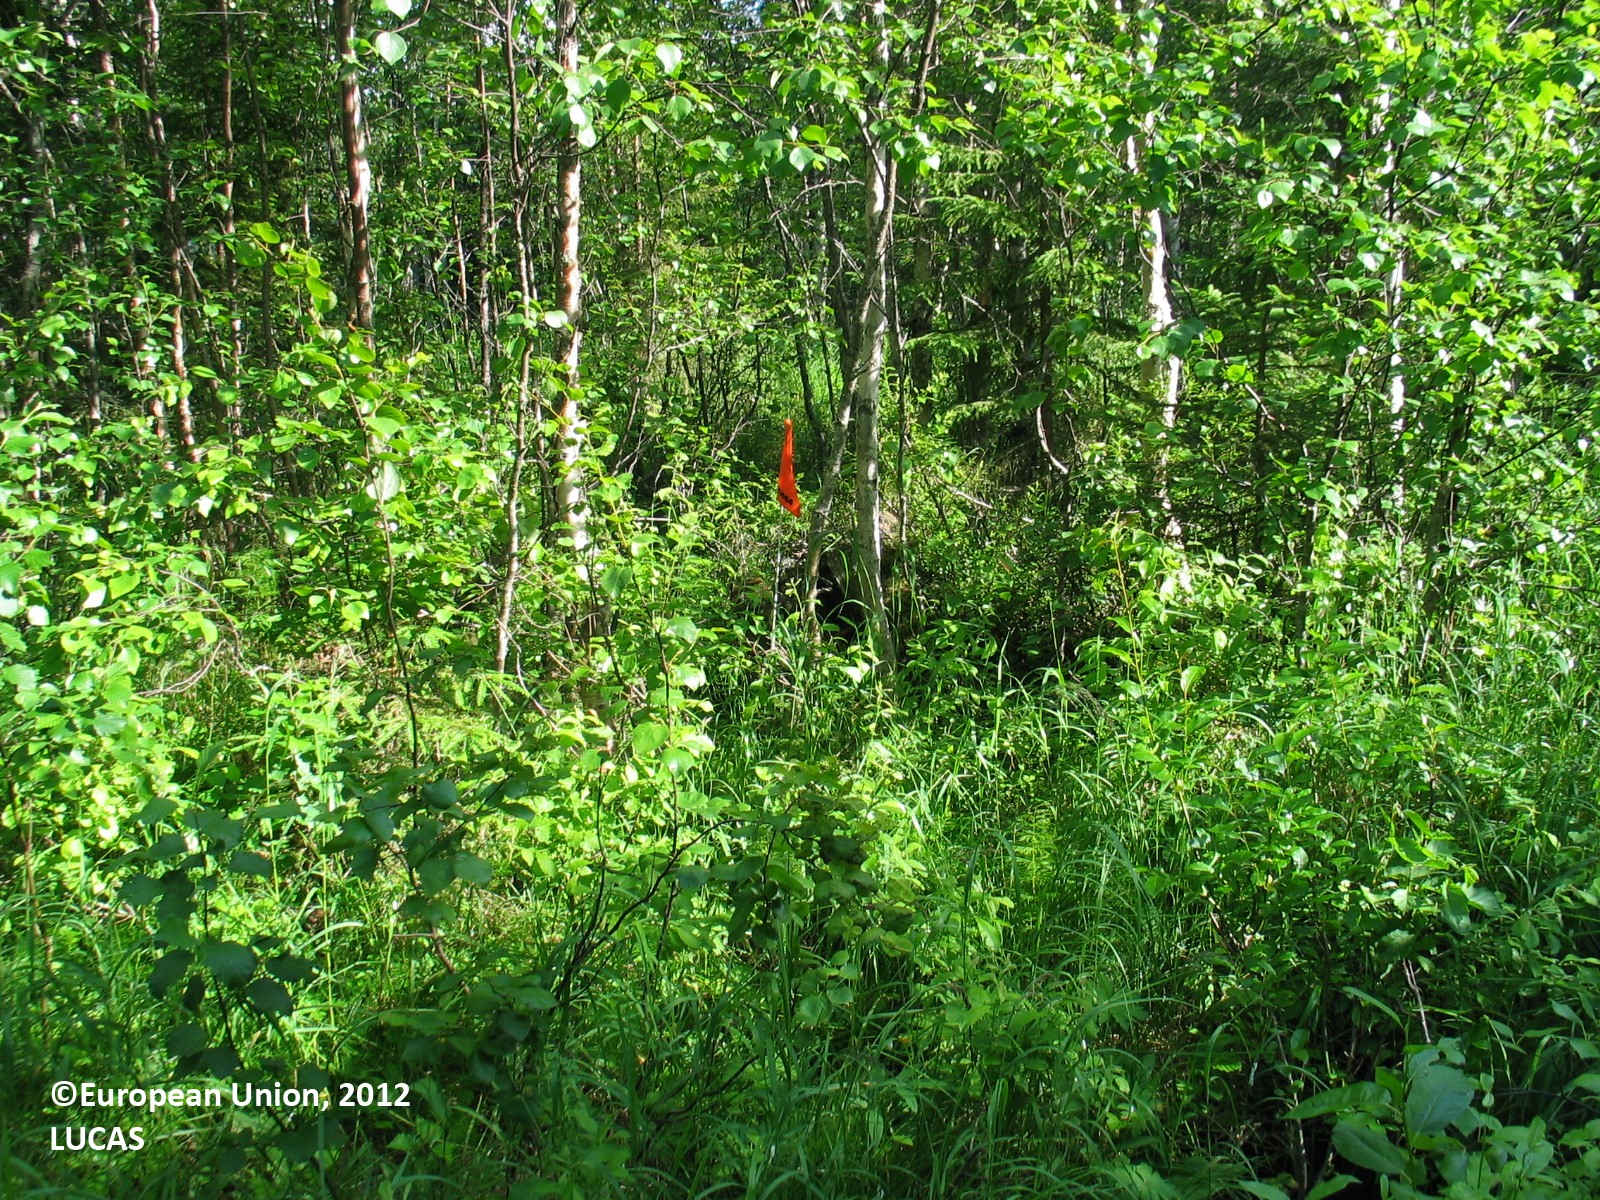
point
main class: Woodland
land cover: Broadleaved woodland
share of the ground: 50 - 75 %
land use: Forestry
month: July
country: FI
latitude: 65.9410
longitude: 25.1217
